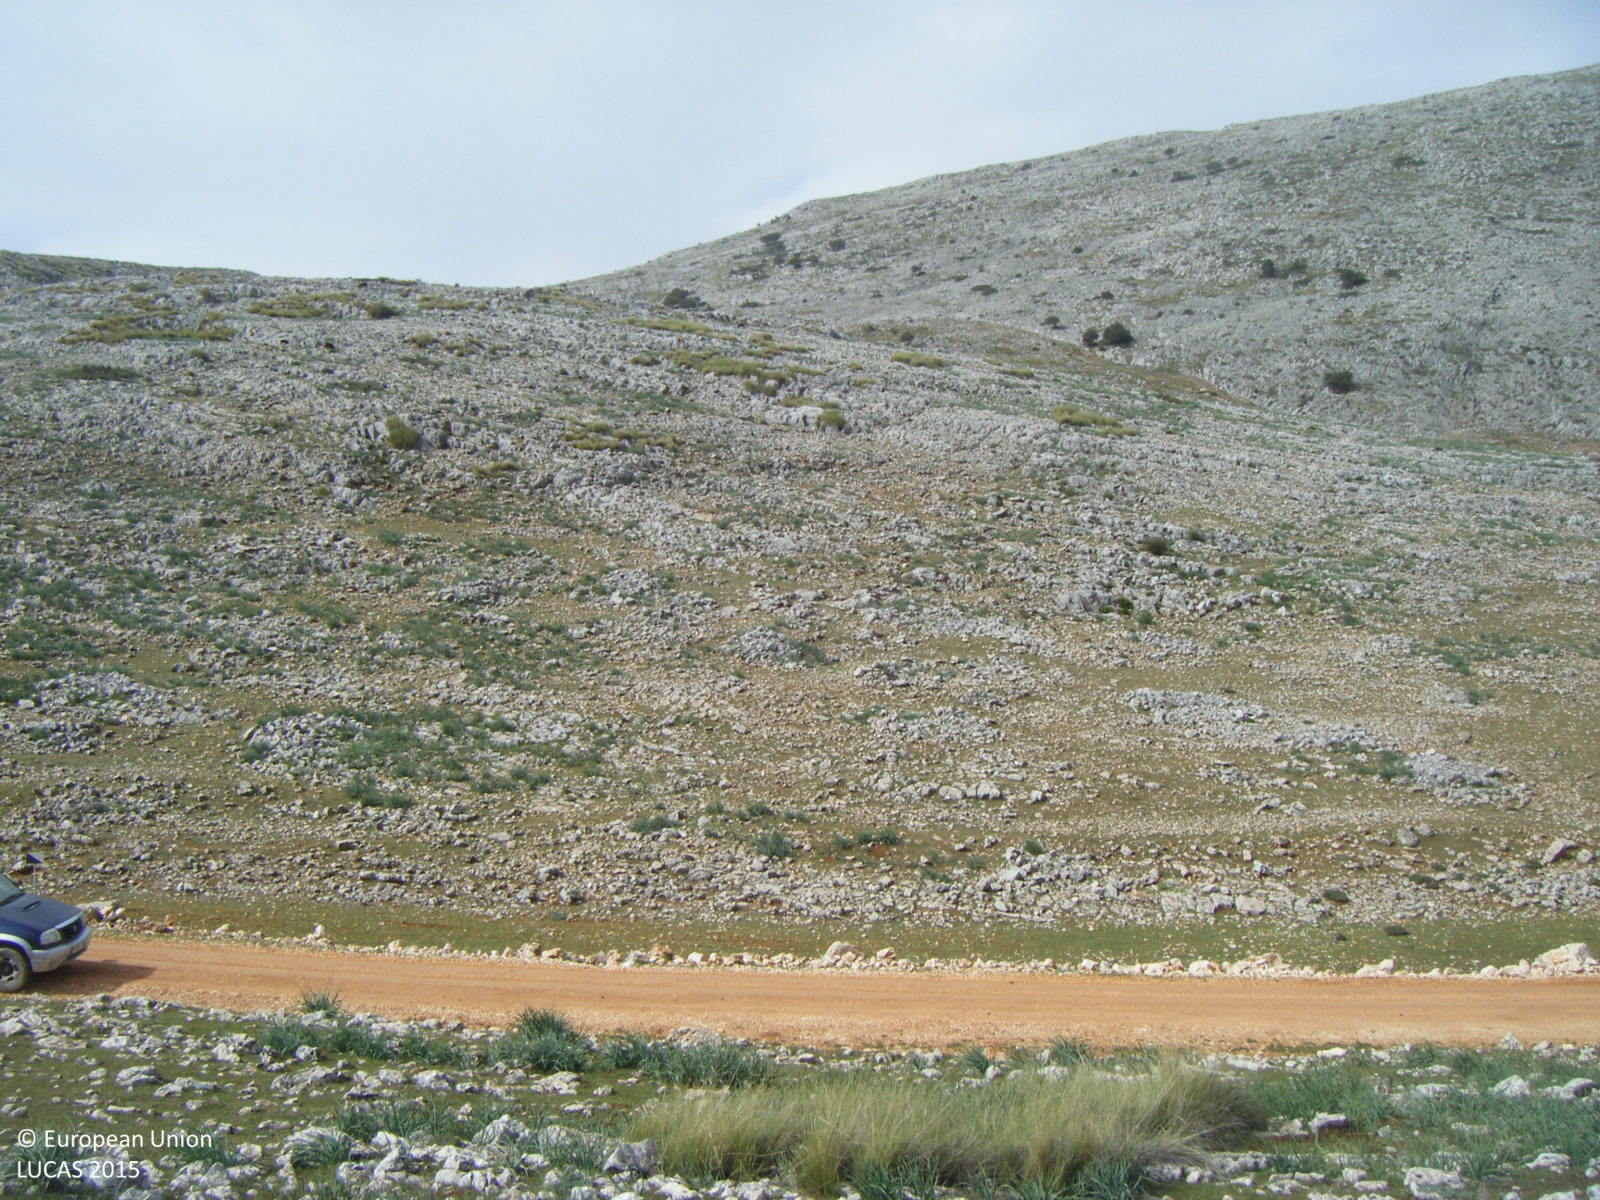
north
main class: Grassland
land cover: Grassland without tree/shrub cover
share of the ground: > 75 %
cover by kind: herbaceous plants 75 %, consolidated bare surface 25 %
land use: Agriculture (excluding fallow land and kitchen gardens)
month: April
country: ES
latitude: 37.0580
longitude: -4.1055
